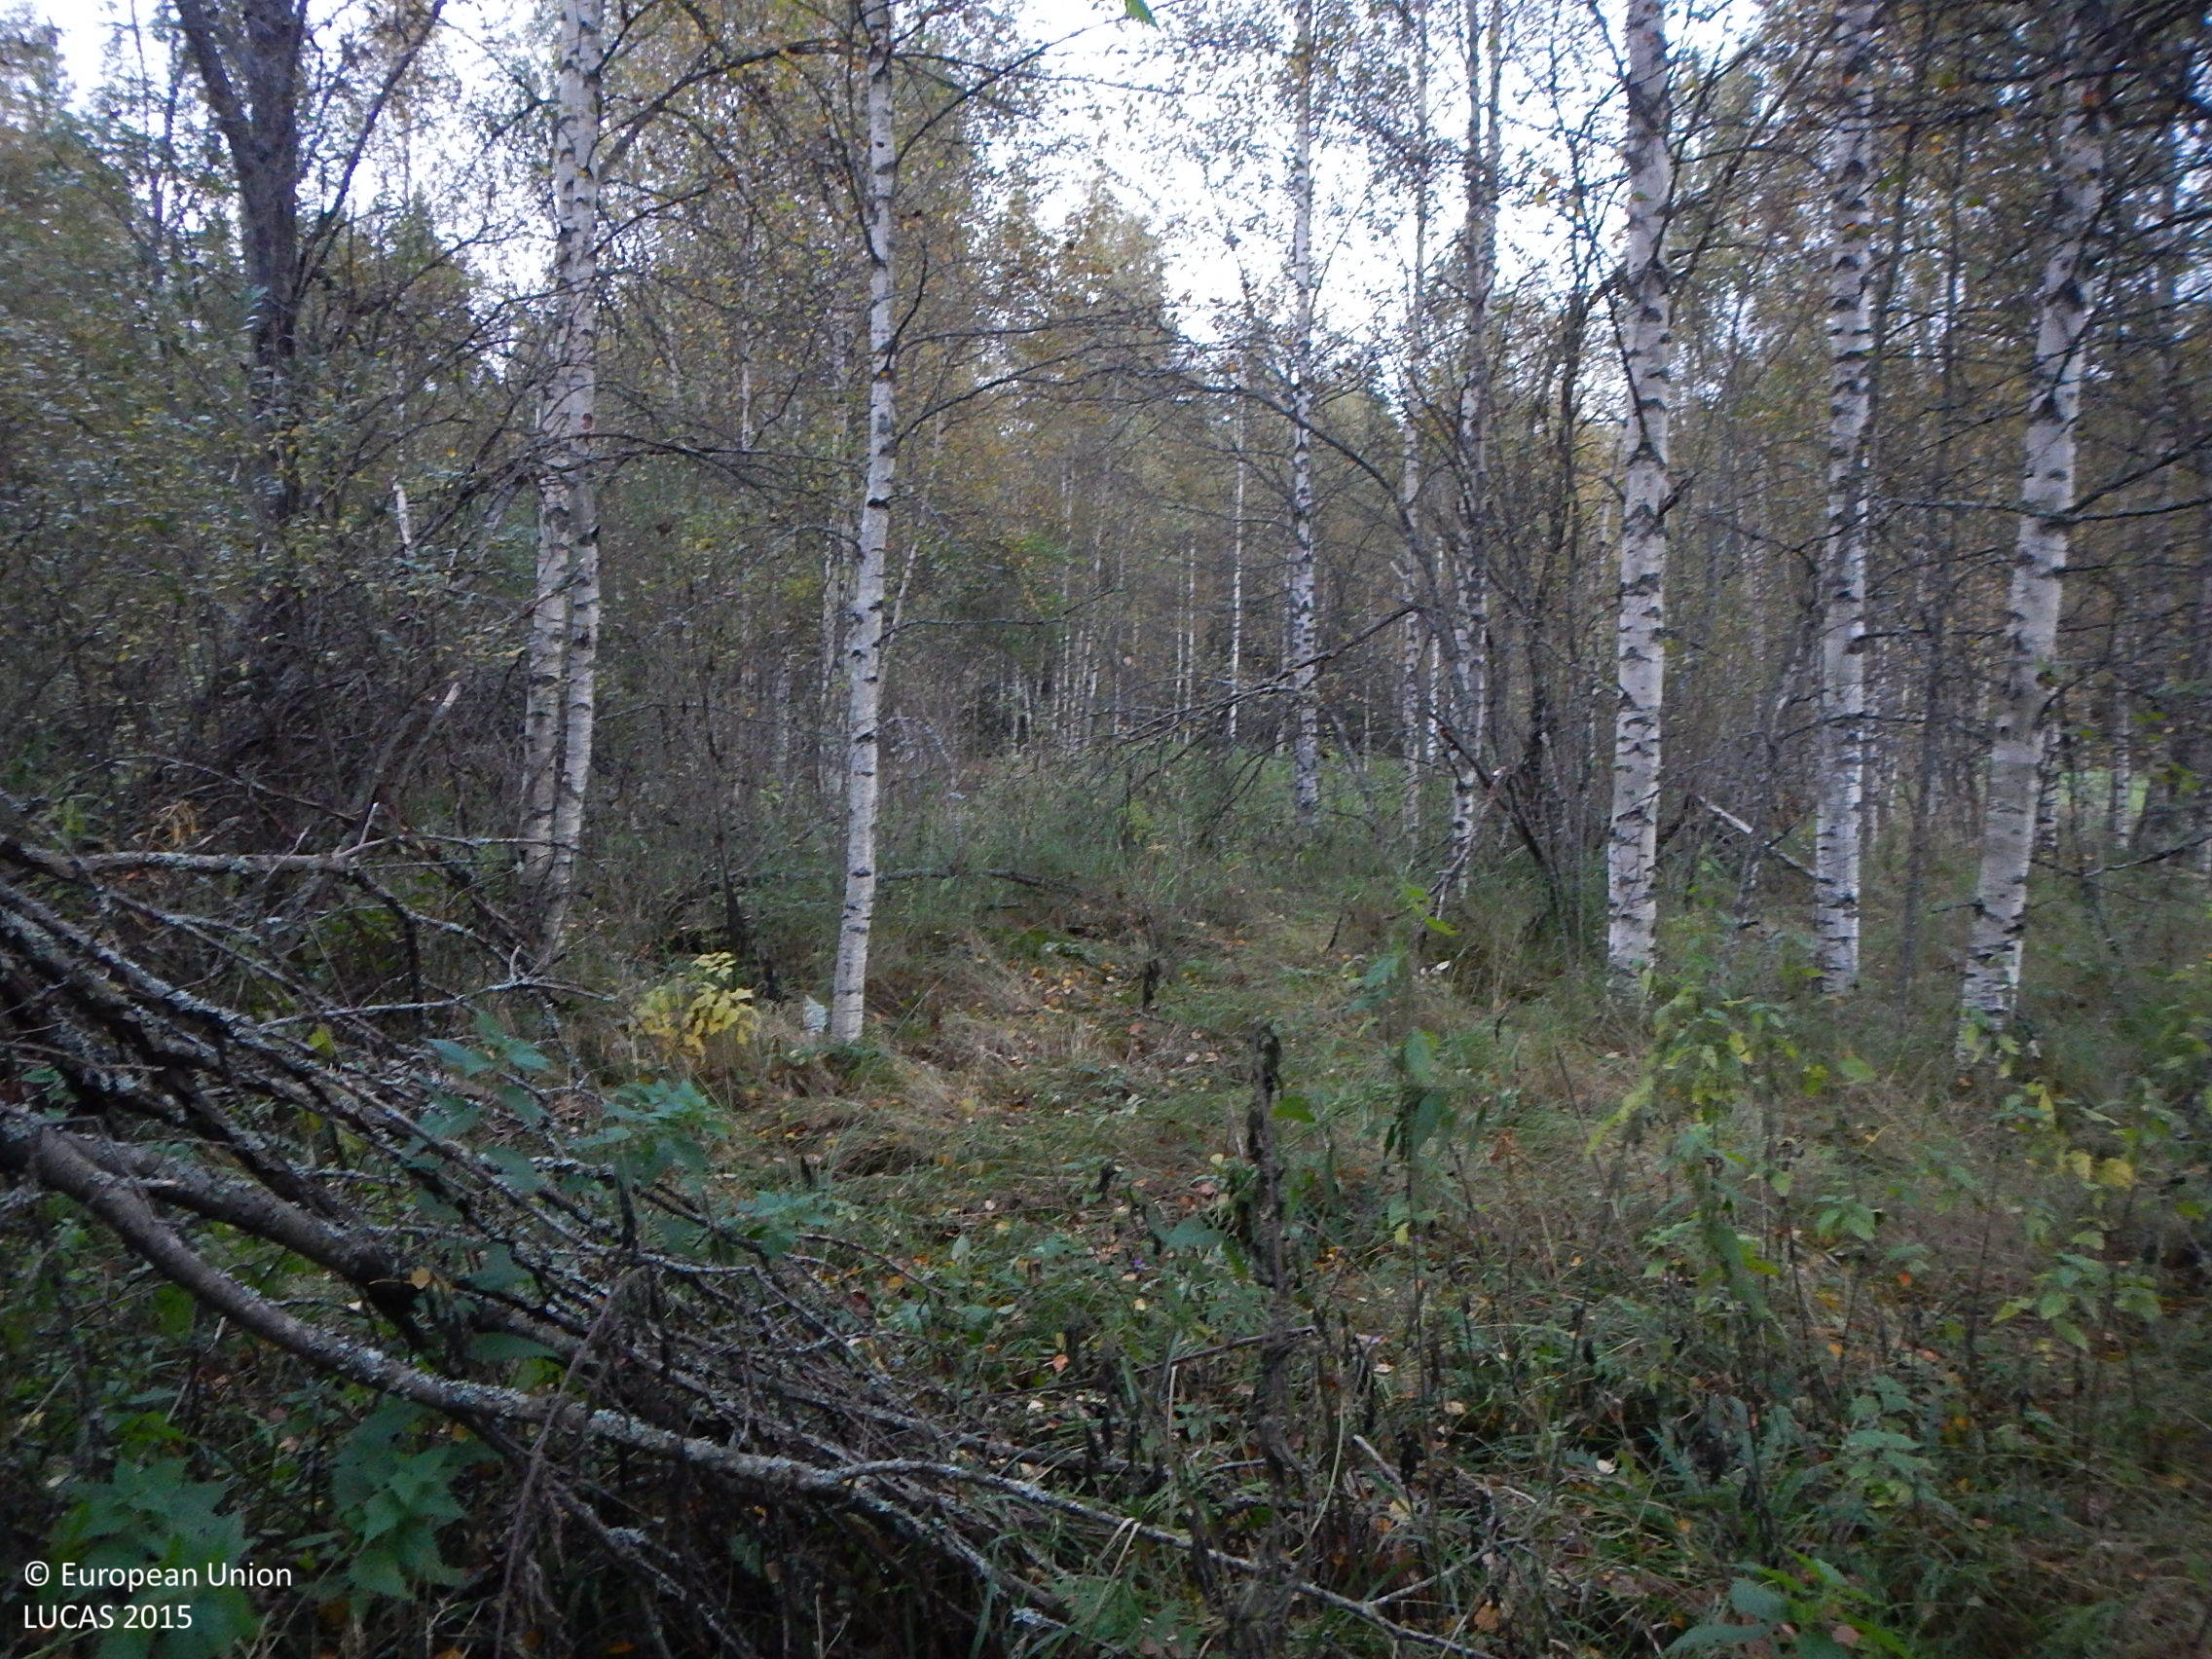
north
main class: Woodland
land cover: Broadleaved woodland
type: non-riverine alder, birch or aspen forest
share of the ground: 50 - 75 %
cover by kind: broadleaved forest trees 70 %, herbaceous plants 30 %
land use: Forestry
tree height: > 5 m
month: September
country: FI
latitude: 61.8700
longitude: 22.7072
